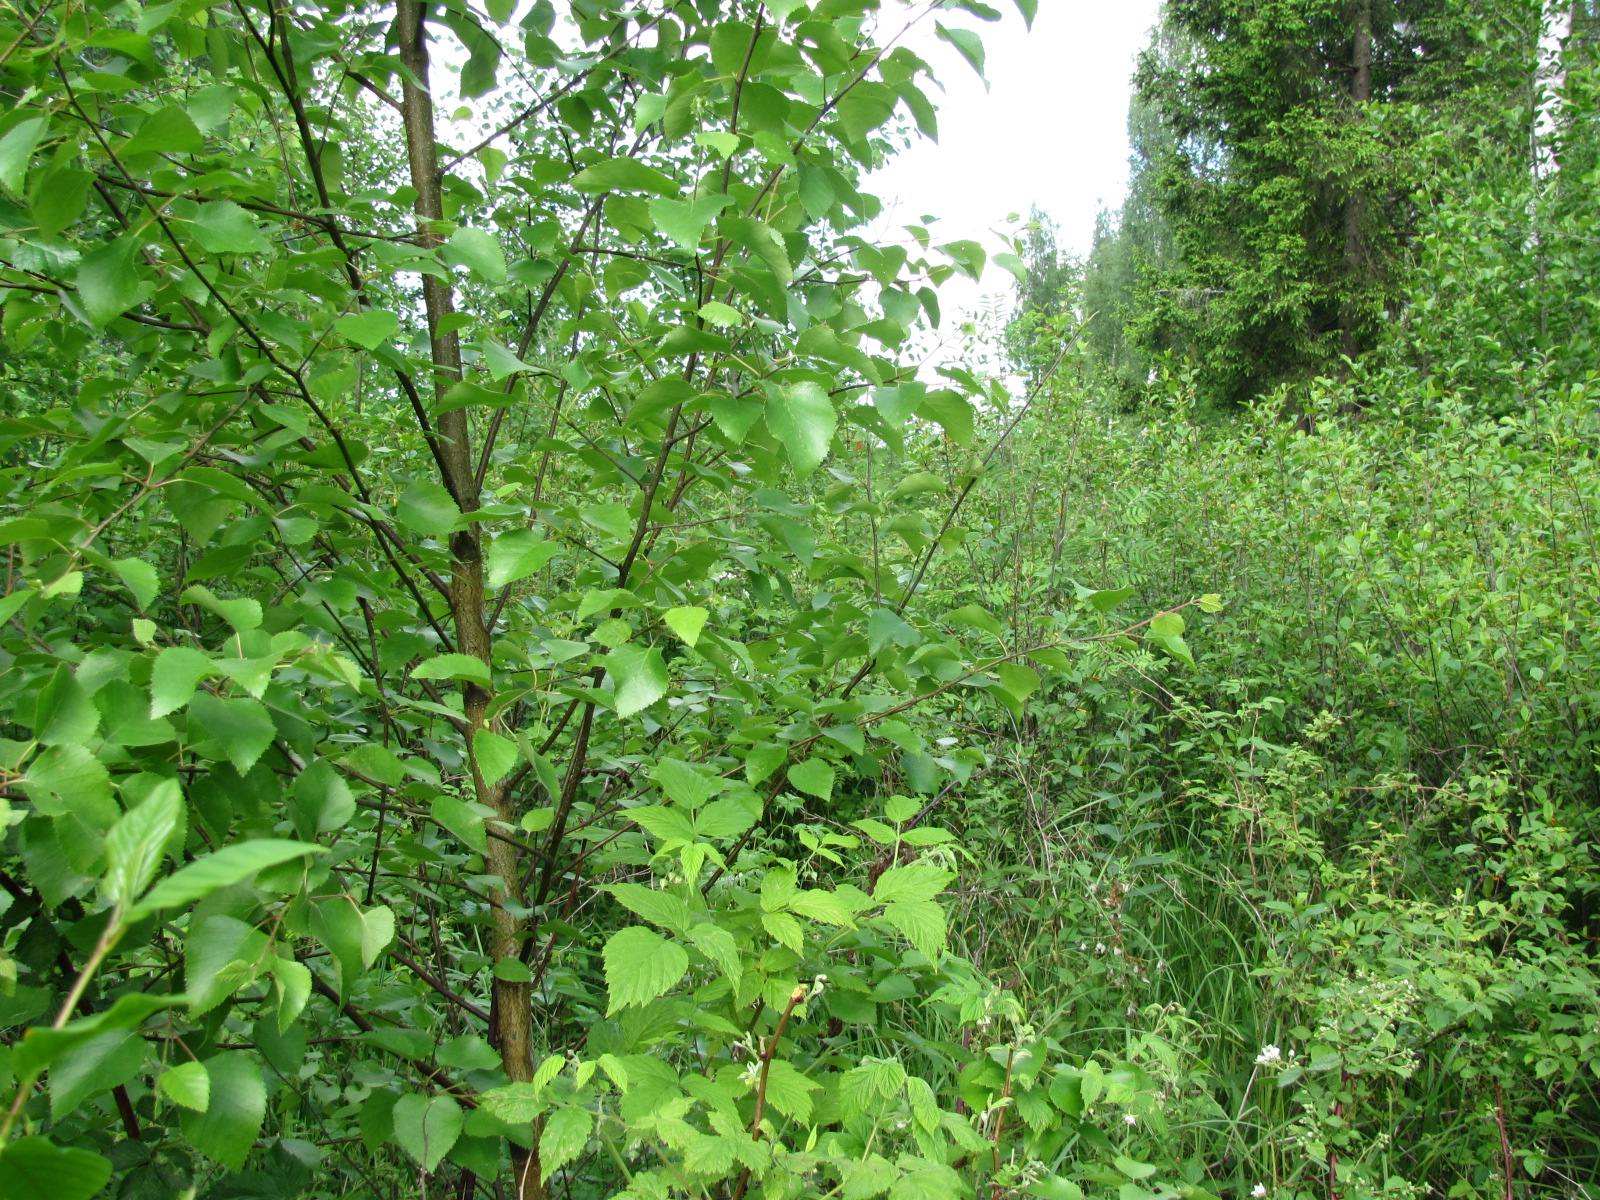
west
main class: Woodland
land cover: Broadleaved woodland
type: non-riverine alder, birch or aspen forest
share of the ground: 50 - 75 %
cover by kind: broadleaved forest trees 70 %, shrubs 30 %
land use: Forestry
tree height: < 5 m
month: June
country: LV
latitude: 56.7040
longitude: 23.9167
